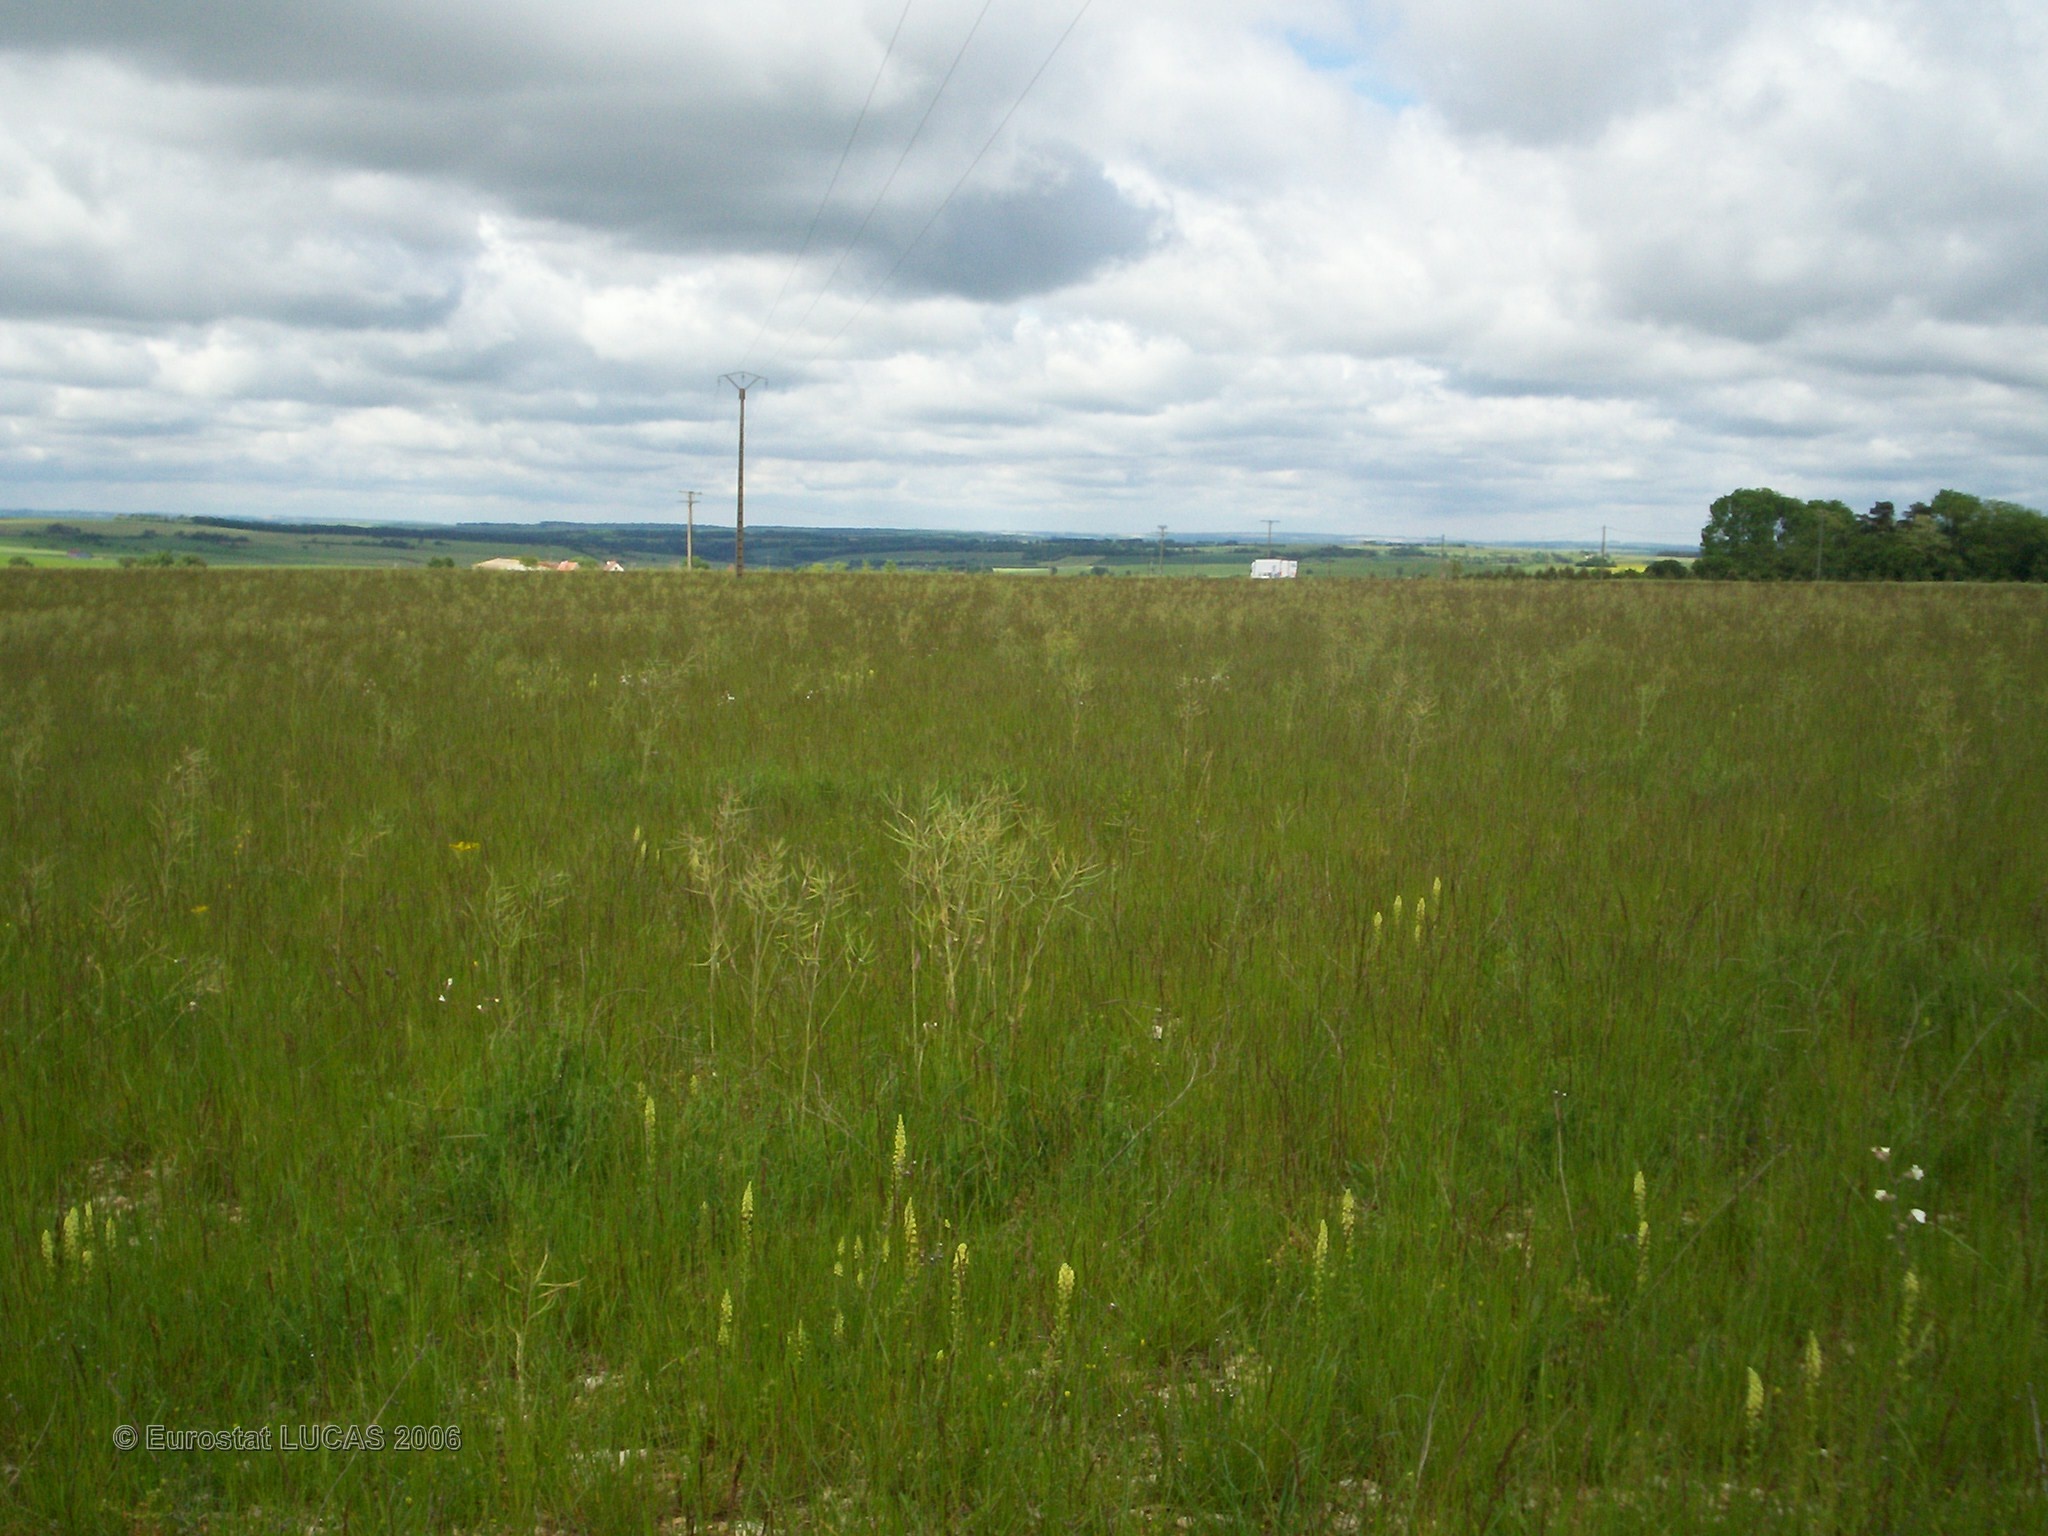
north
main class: Grassland
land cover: Grassland without tree/shrub cover
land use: Agriculture (excluding fallow land and kitchen gardens)
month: May
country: FR
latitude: 47.6015
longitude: 3.8655
